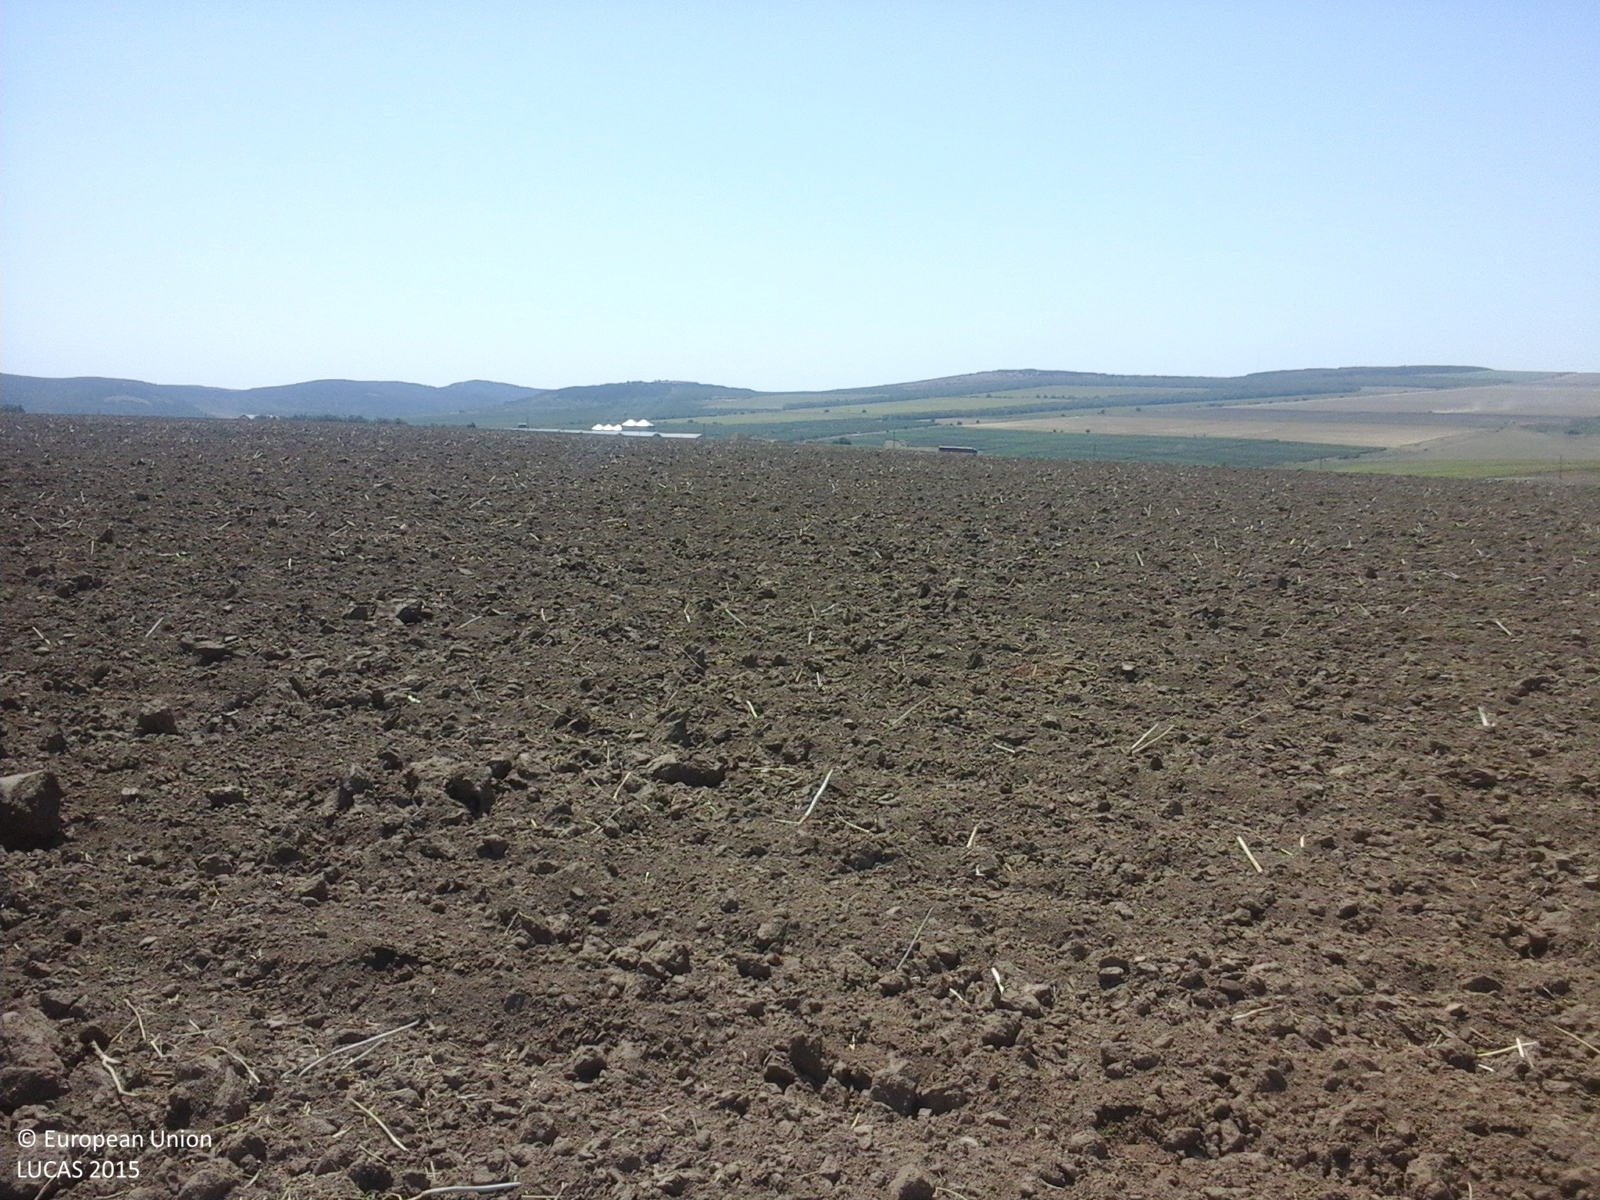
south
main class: Cropland
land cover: Rape and turnip rape
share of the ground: < 10 %
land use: Agriculture (excluding fallow land and kitchen gardens)
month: August
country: RO
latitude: 44.5462
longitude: 28.2278
